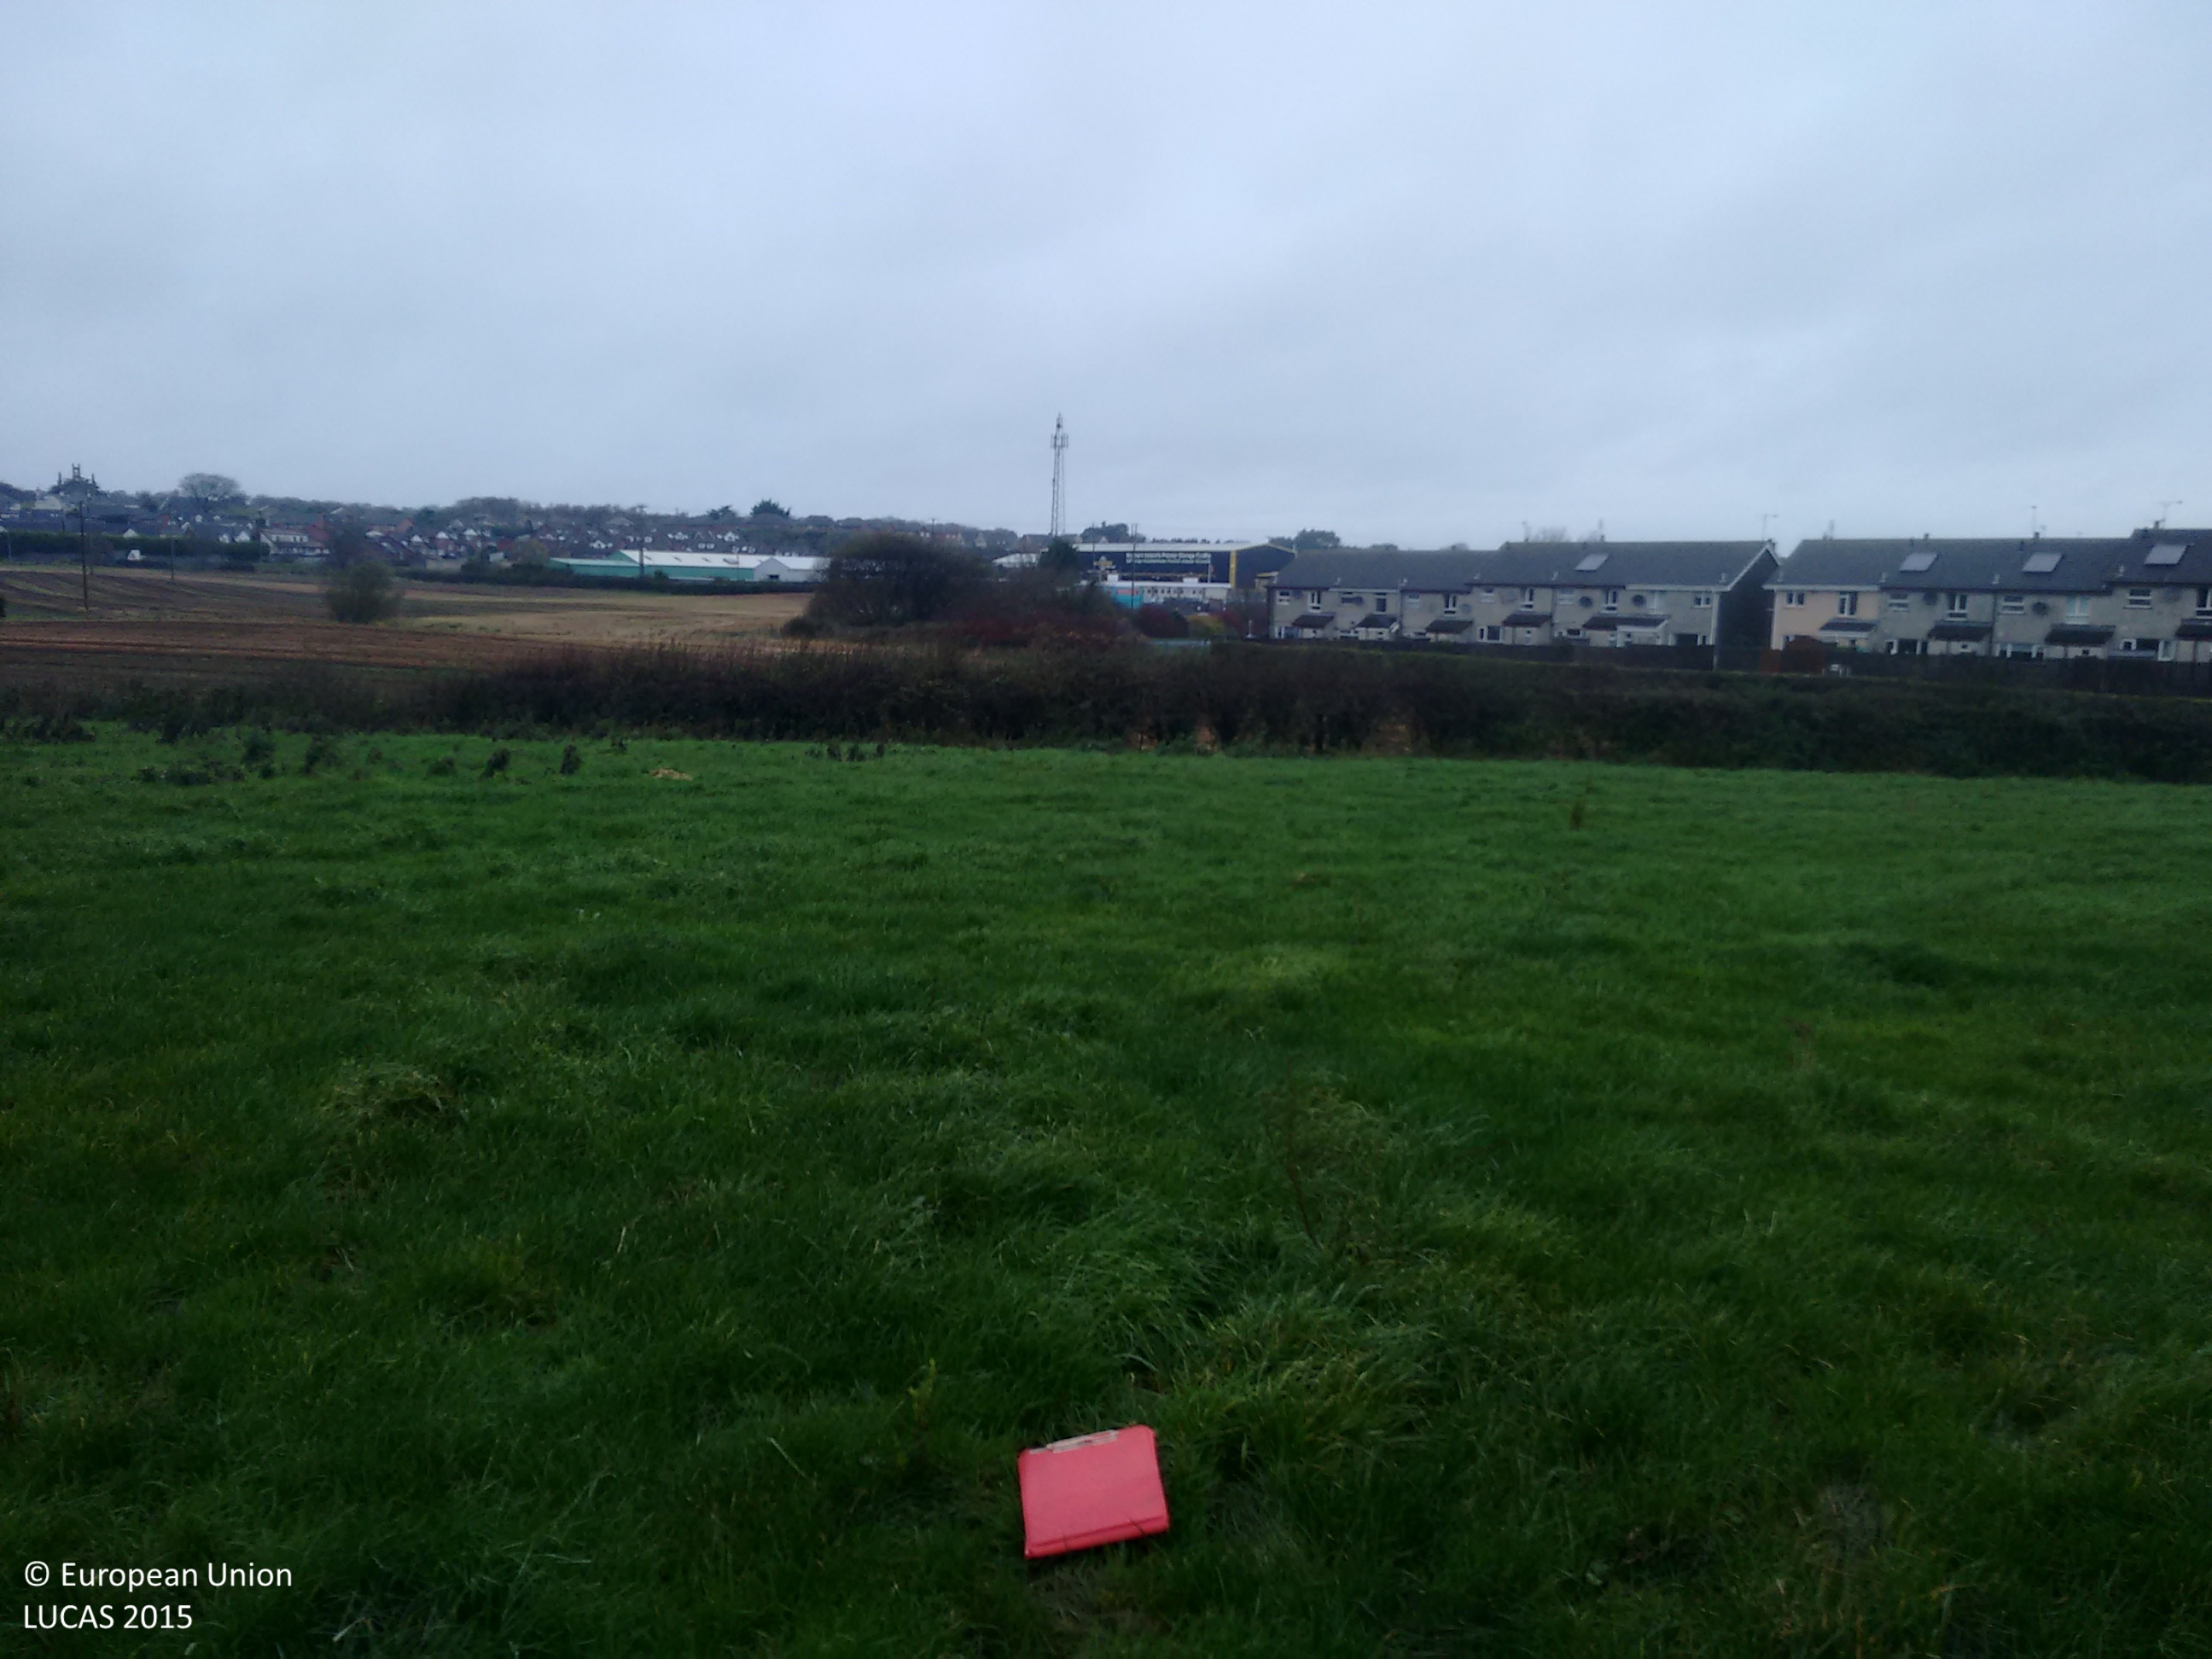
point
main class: Grassland
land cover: Grassland without tree/shrub cover
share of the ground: > 75 %
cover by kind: herbaceous plants 100 %
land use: Agriculture (excluding fallow land and kitchen gardens)
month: November
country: GB
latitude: 54.6290
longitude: -5.6682
